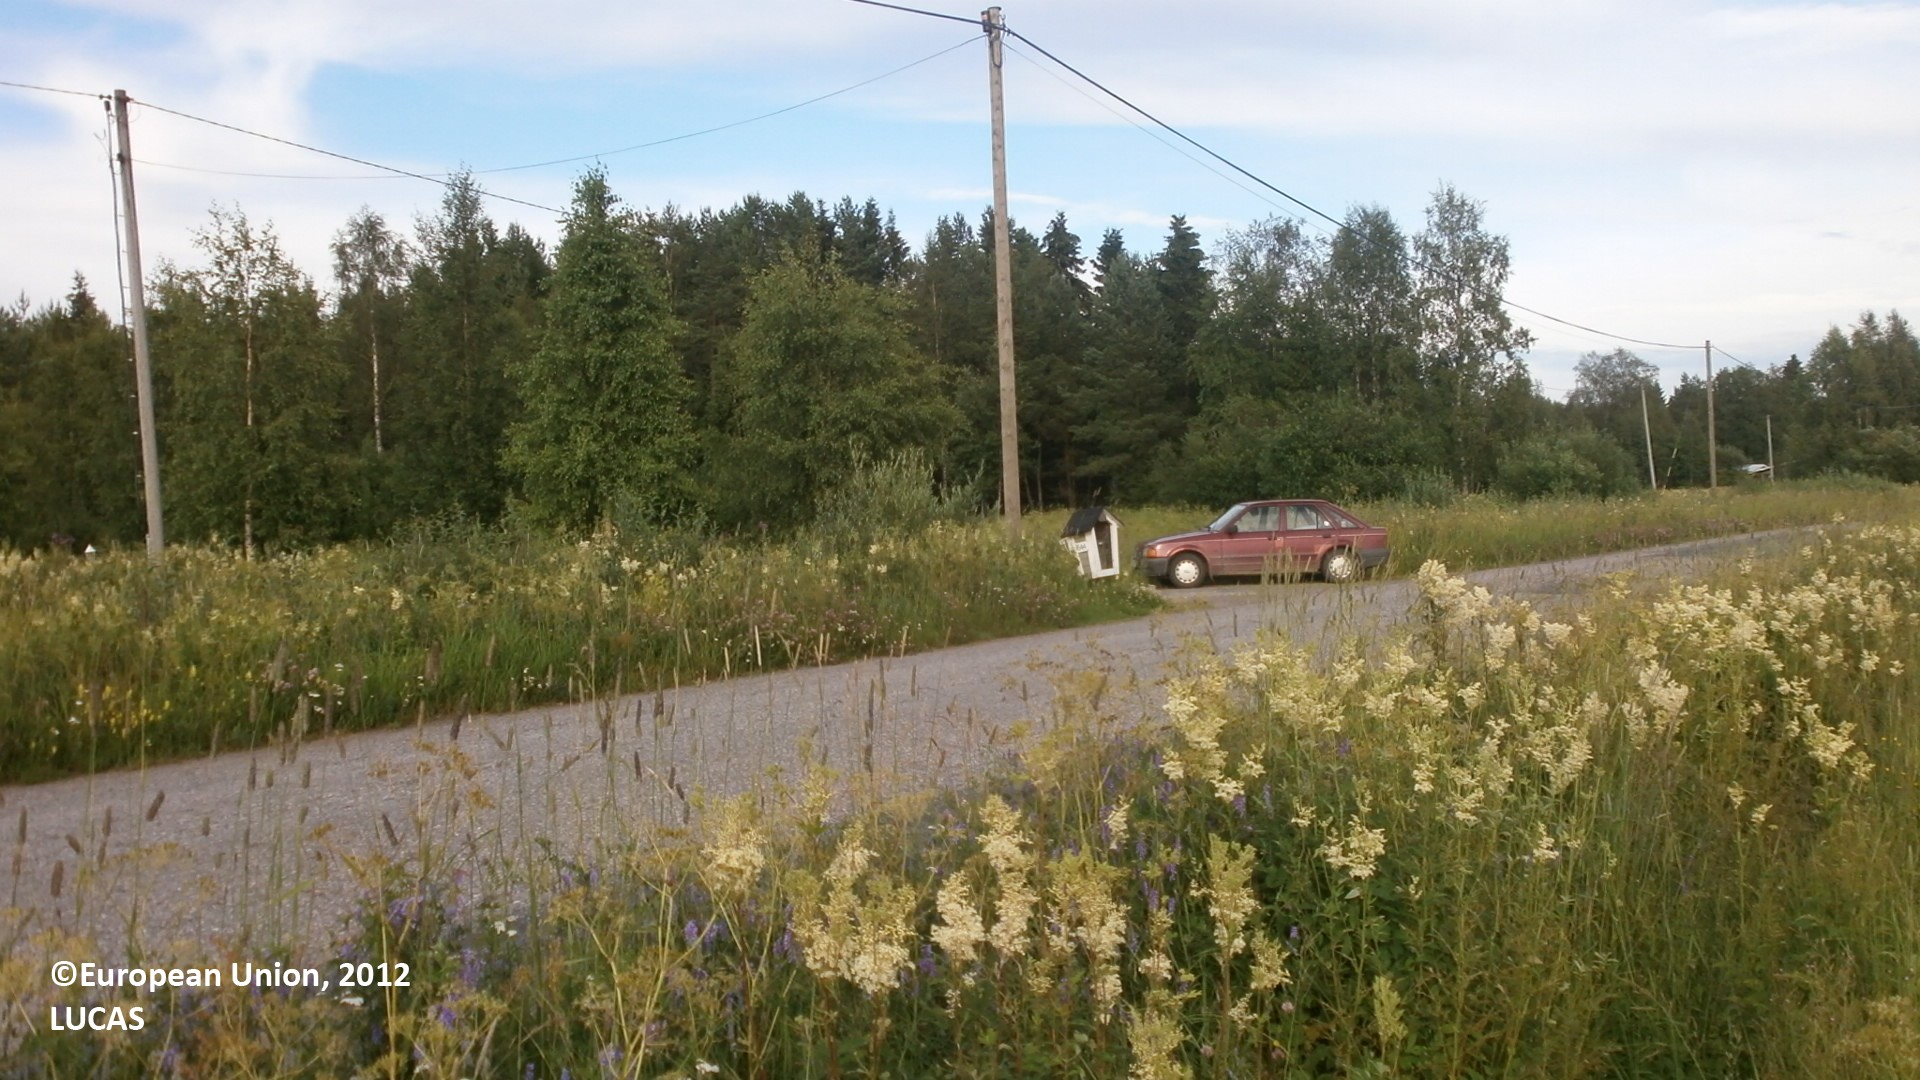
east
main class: Cropland
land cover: Barley
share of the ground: > 75 %
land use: Agriculture (excluding fallow land and kitchen gardens)
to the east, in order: Barley; Shruby margins; Ditches and canals; Shruby margins; Paved roads, cycling and walking lanes; Shruby margins; Ditches and canals; Electric lines; Grassland without tree/shrub cover; Electric lines; Grassland without tree/shrub cover; Ditches and canals; Grassland without tree/shrub cover; Pine dominated mixed woodland
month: July
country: FI
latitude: 64.4073
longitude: 24.3209
